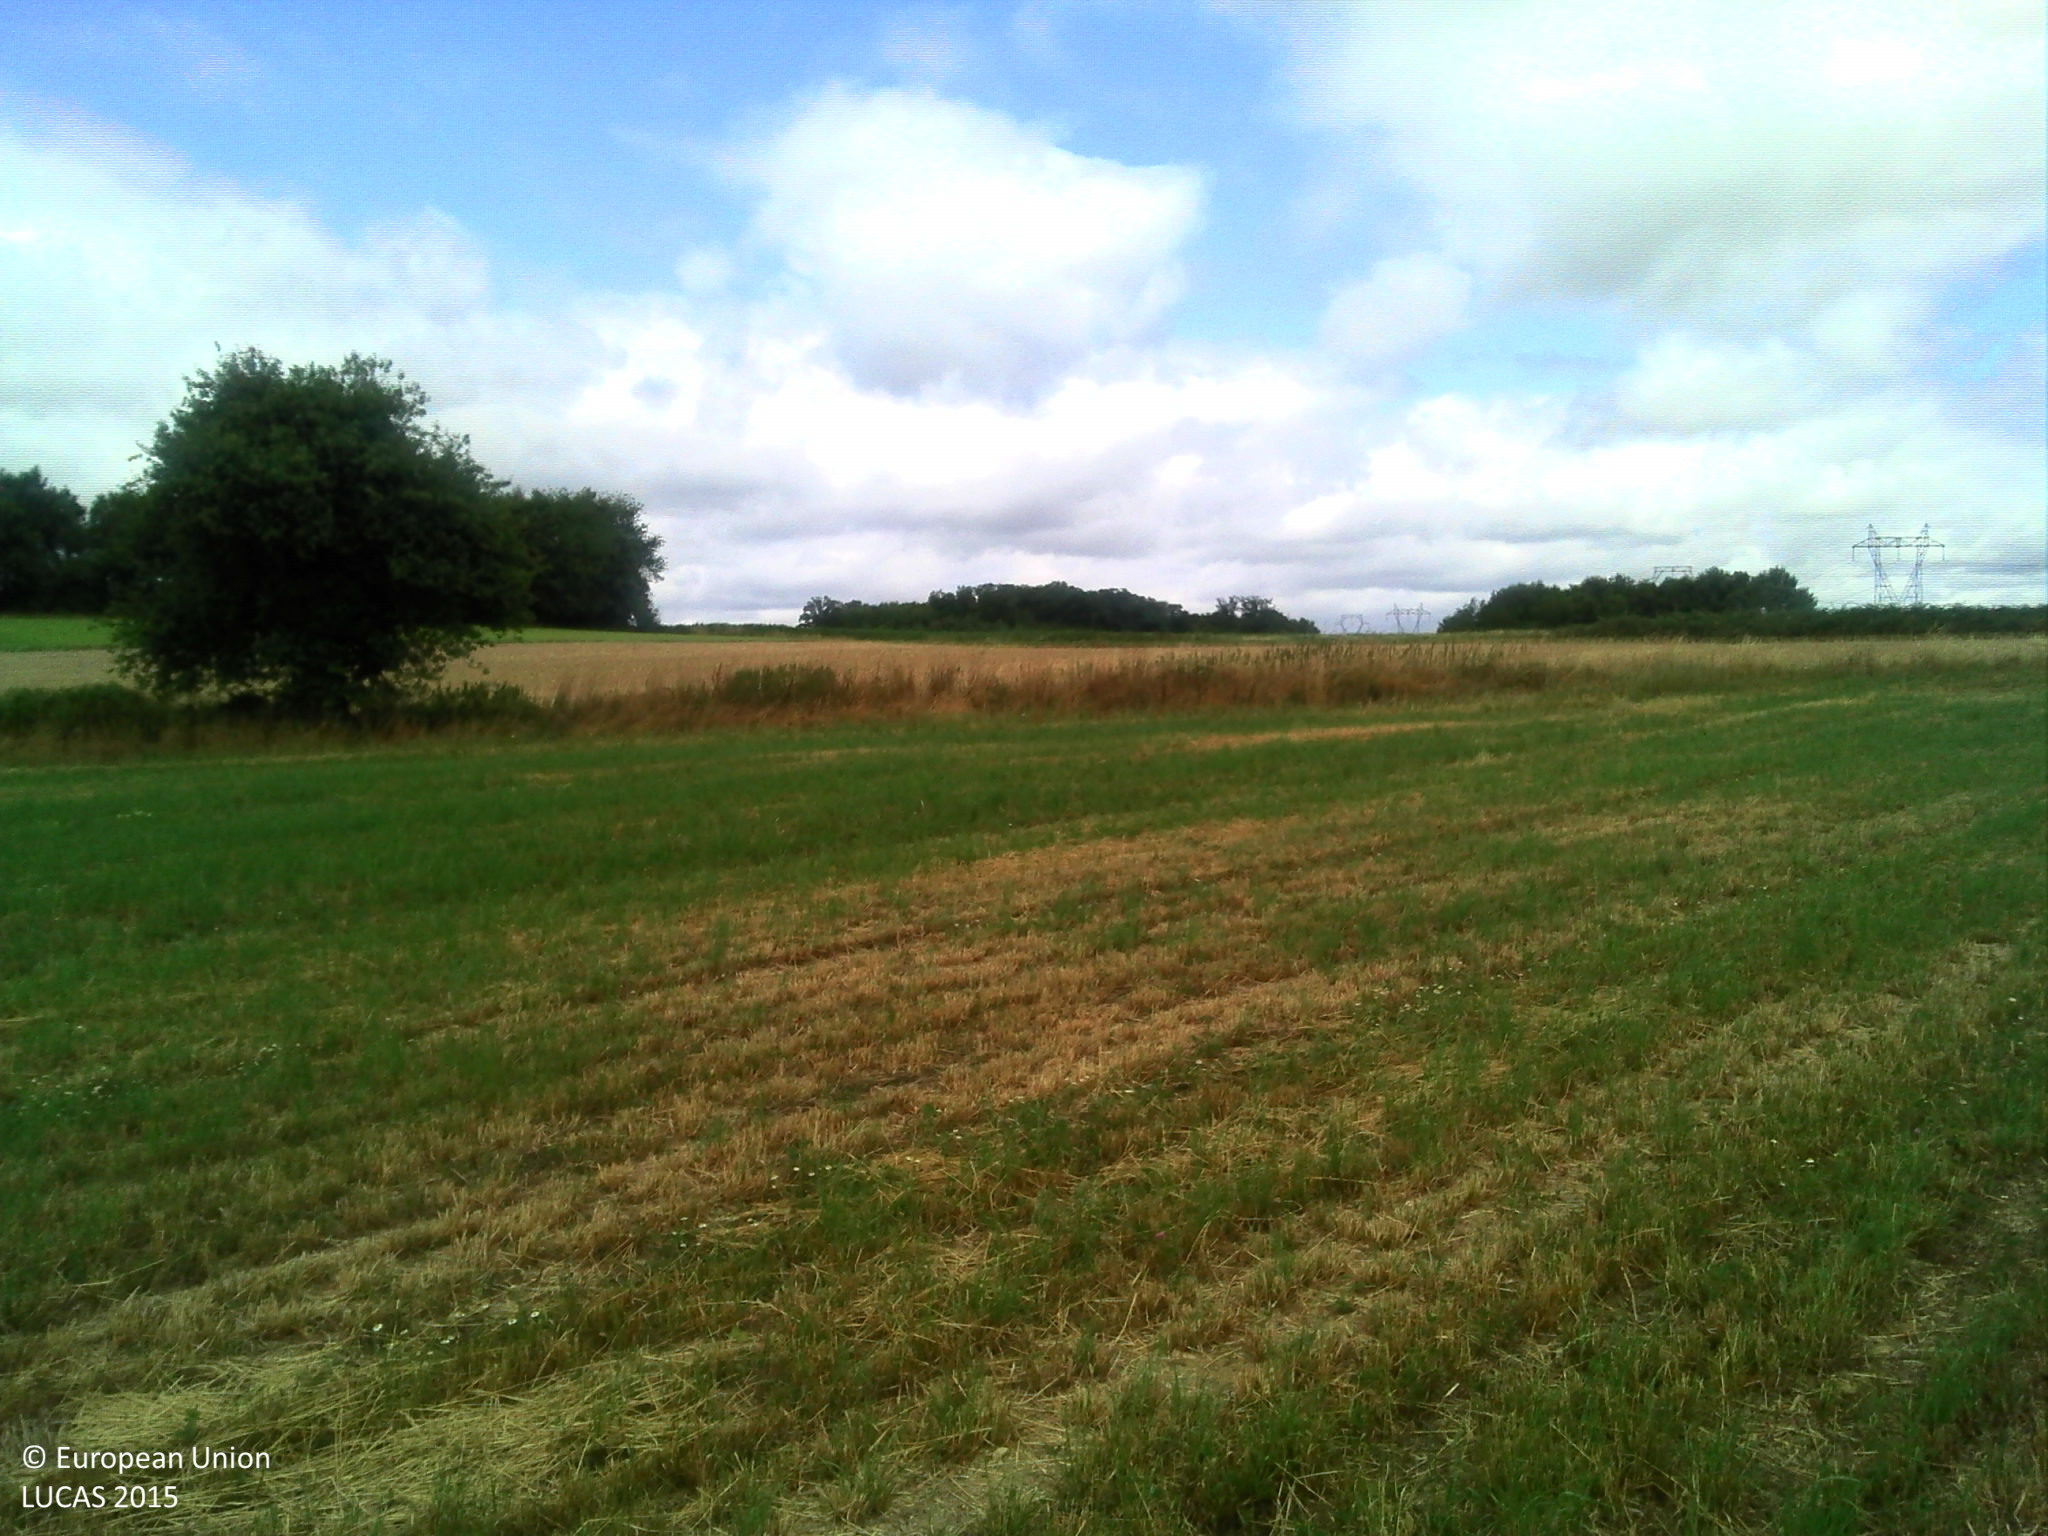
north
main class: Cropland
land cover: Temporary grasslands
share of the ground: > 75 %
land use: Agriculture (excluding fallow land and kitchen gardens)
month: July
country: FR
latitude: 46.3490
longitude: 1.6357
